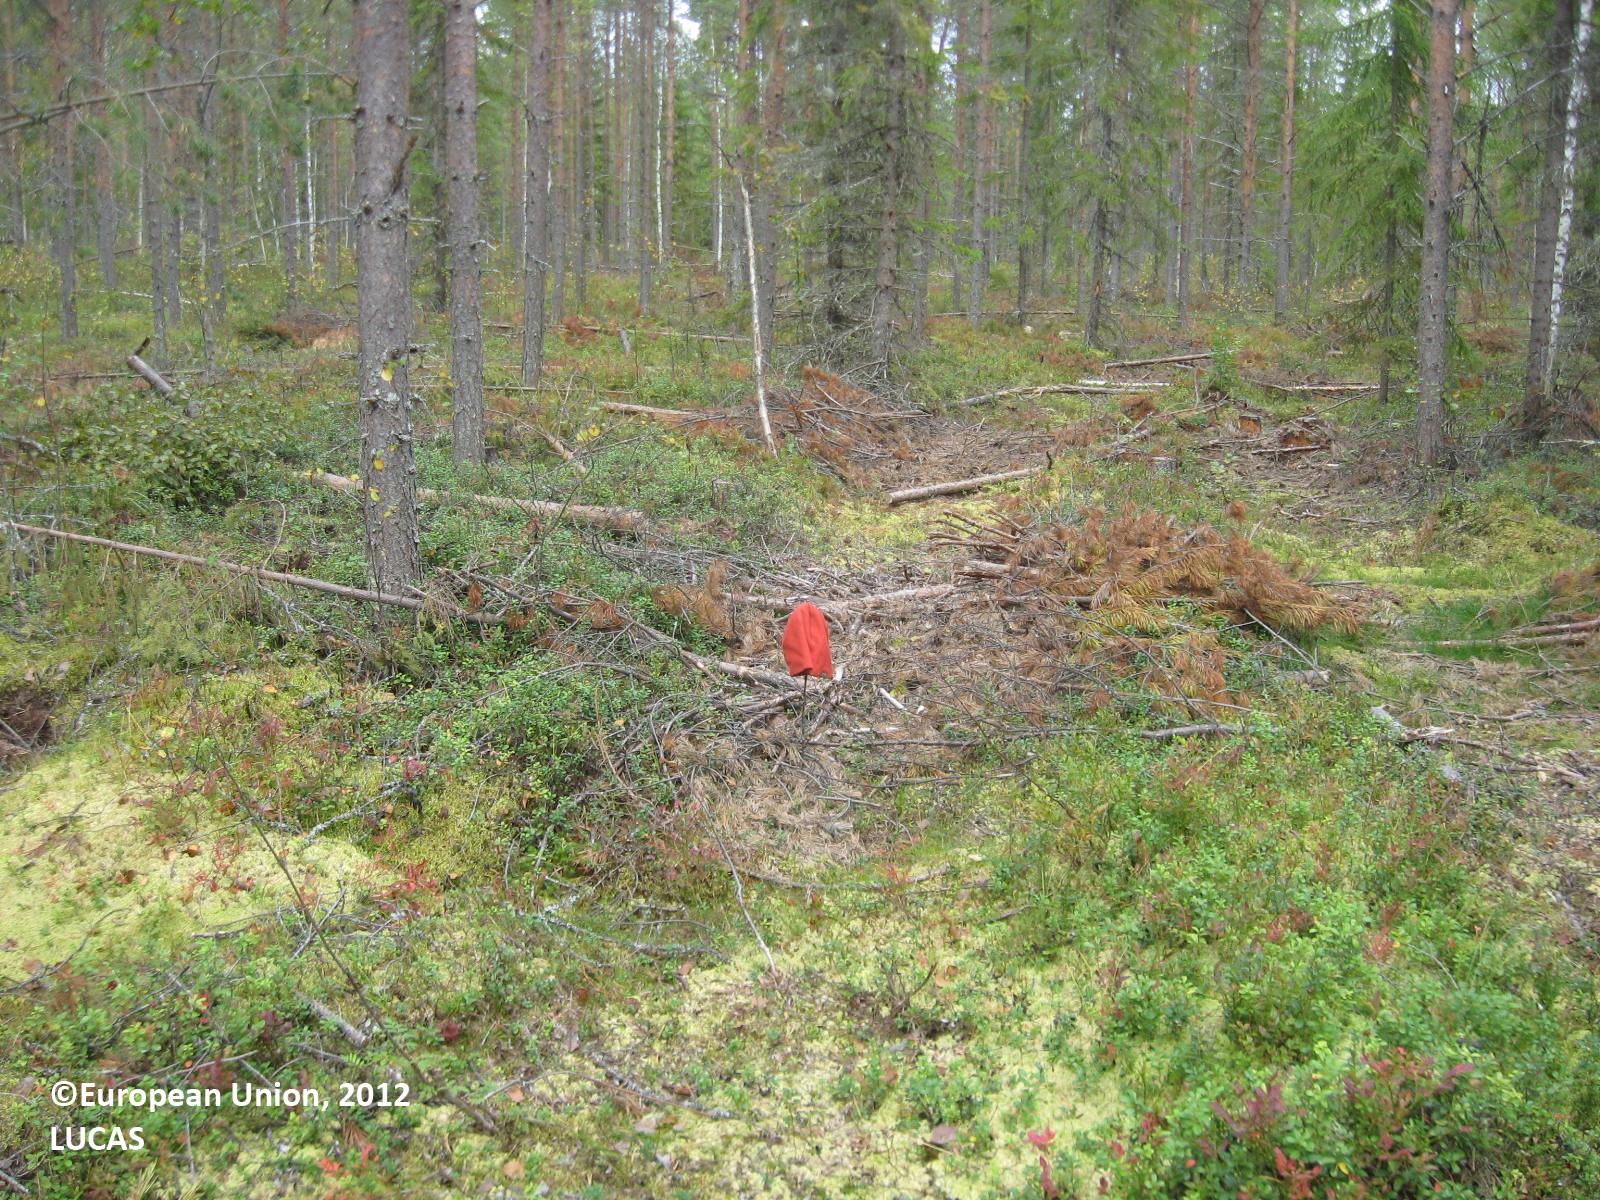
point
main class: Woodland
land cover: Pine dominated coniferous woodland
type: boreal forest
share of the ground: > 75 %
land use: Forestry
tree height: > 5 m
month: September
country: FI
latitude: 64.0809
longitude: 28.3226
